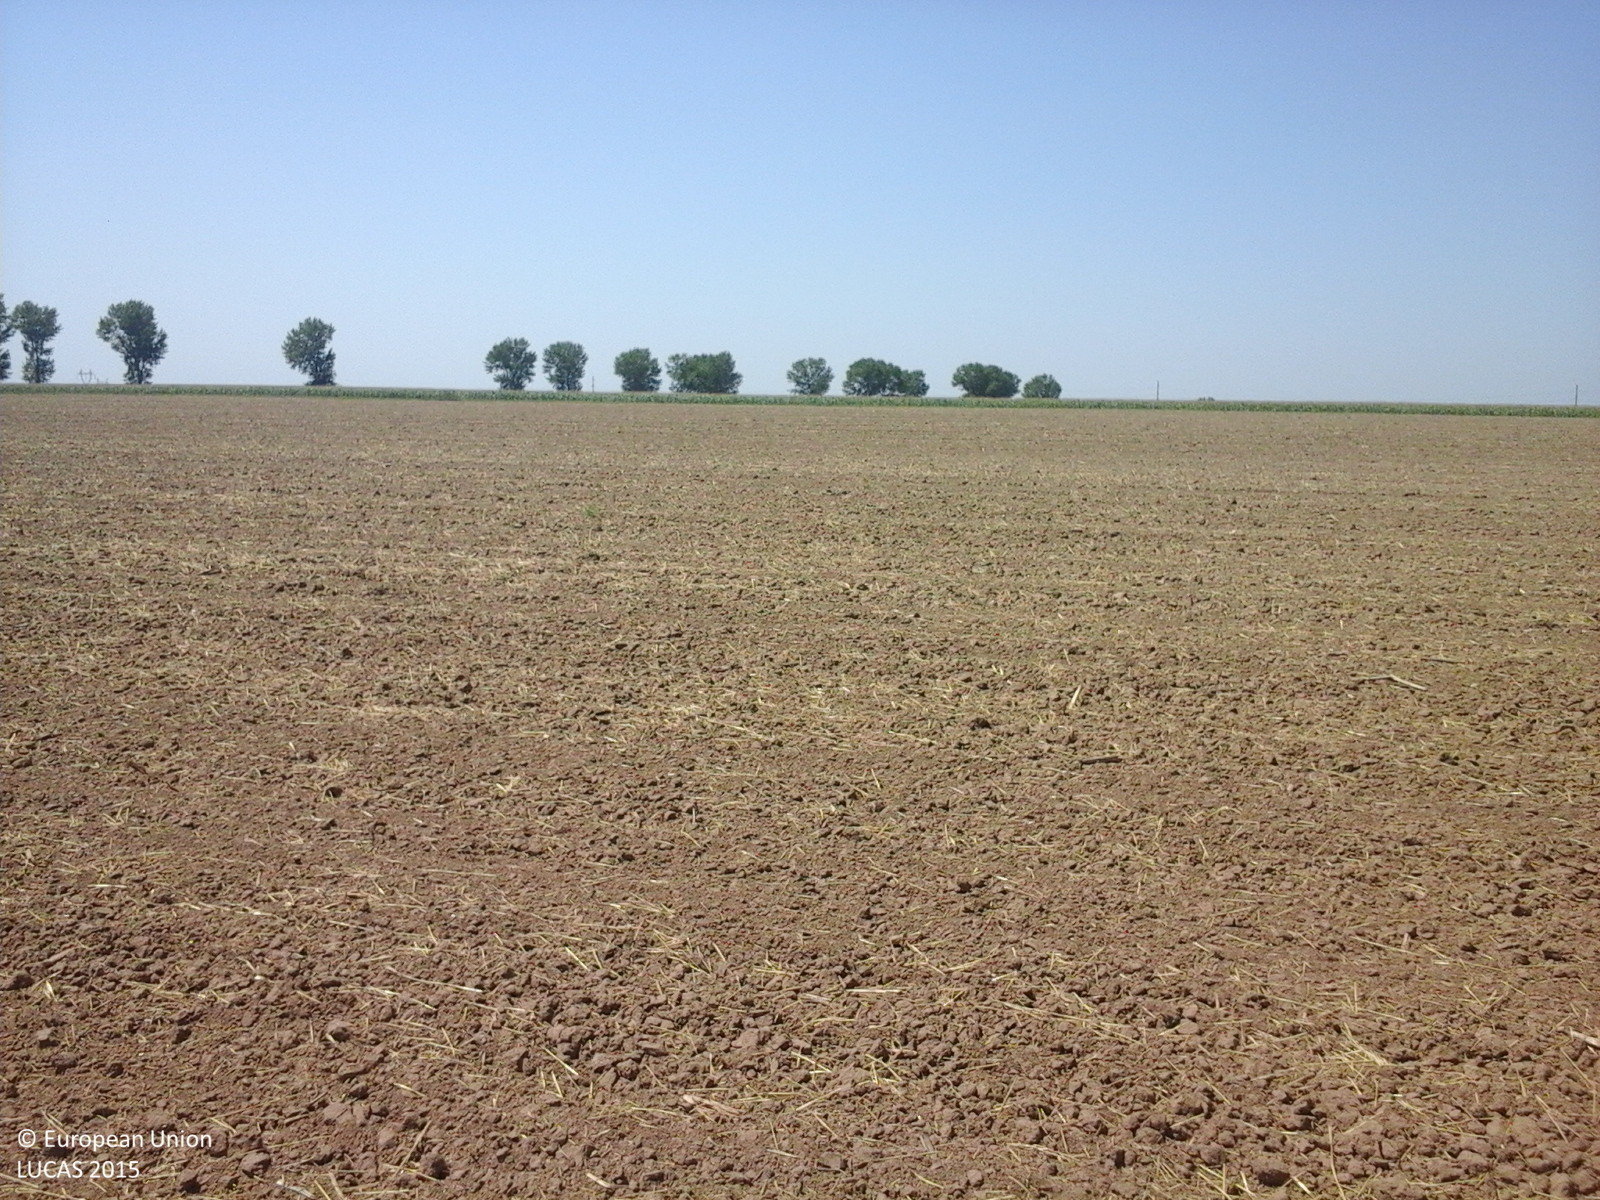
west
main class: Cropland
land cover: Common wheat
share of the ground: < 10 %
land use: Agriculture (excluding fallow land and kitchen gardens)
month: August
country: RO
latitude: 44.6333
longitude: 28.0484
